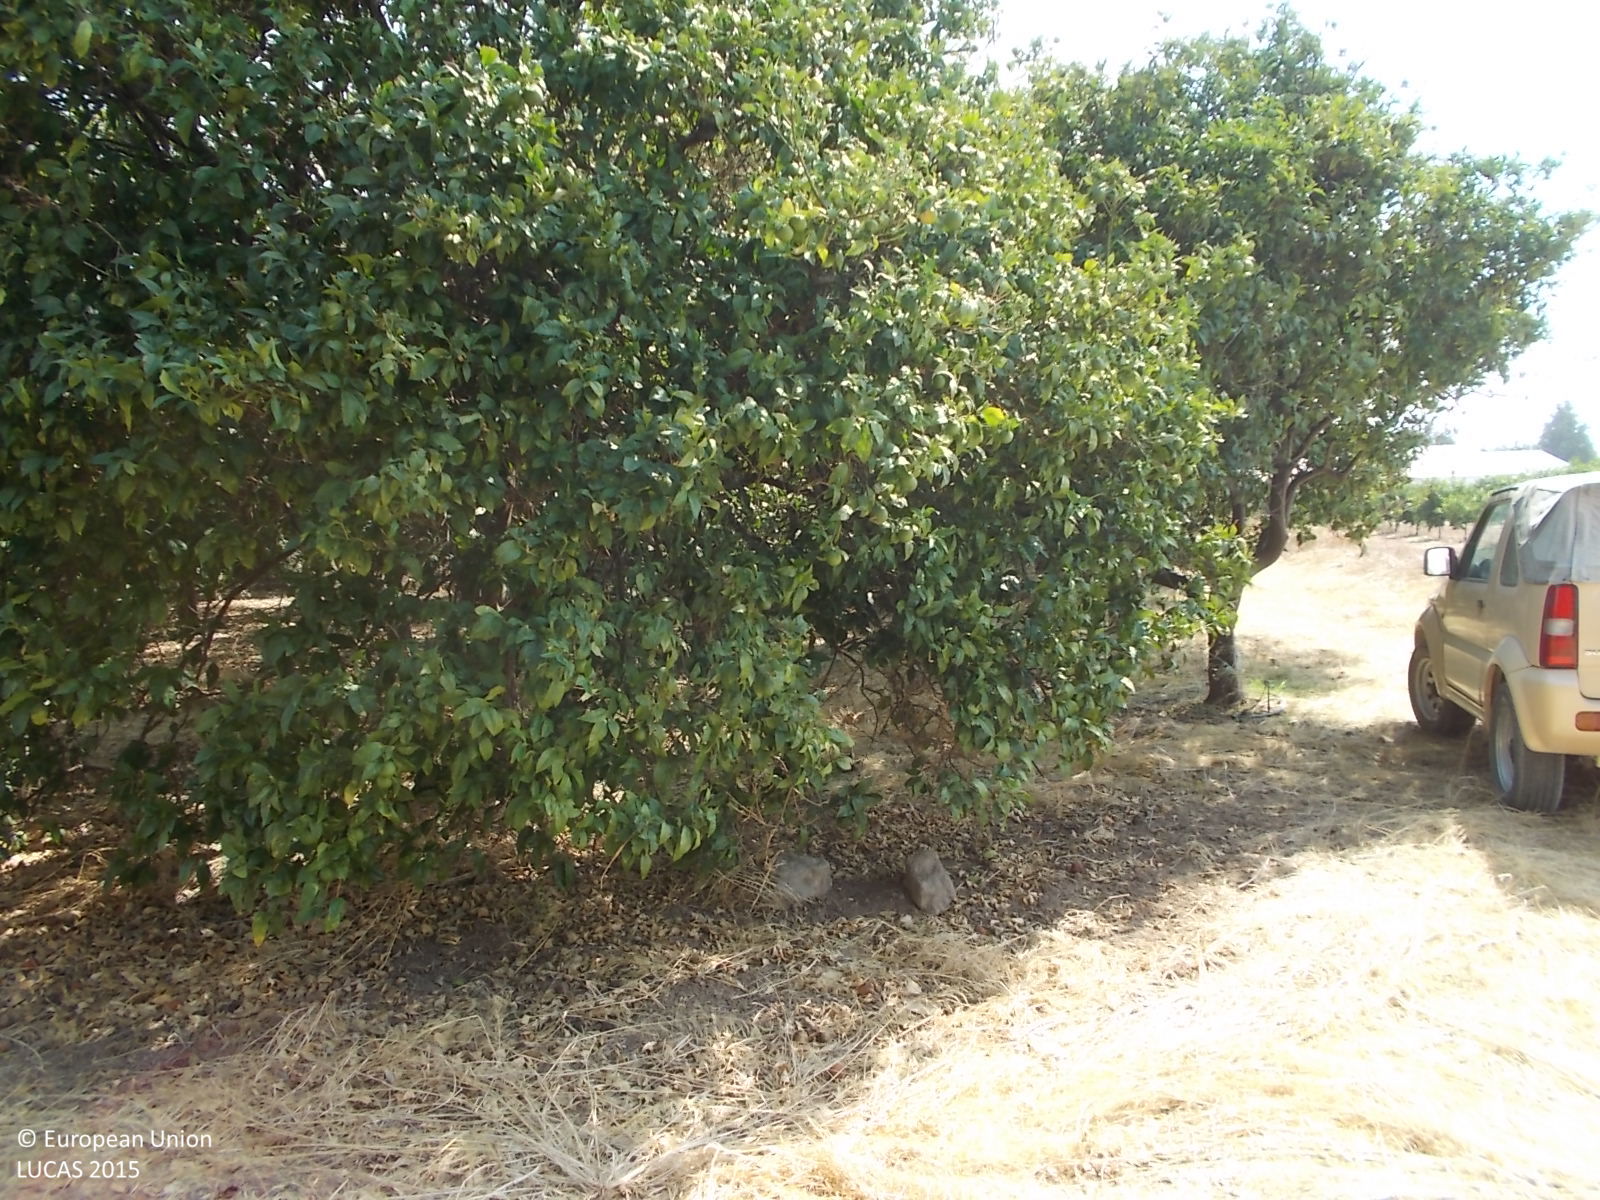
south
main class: Woodland
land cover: Other coniferous woodland
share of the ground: 50 - 75 %
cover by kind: coniferous forest trees 65 %, herbaceous plants 35 %
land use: Agriculture (excluding fallow land and kitchen gardens)
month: May
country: CY
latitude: 34.7272
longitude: 32.5232
